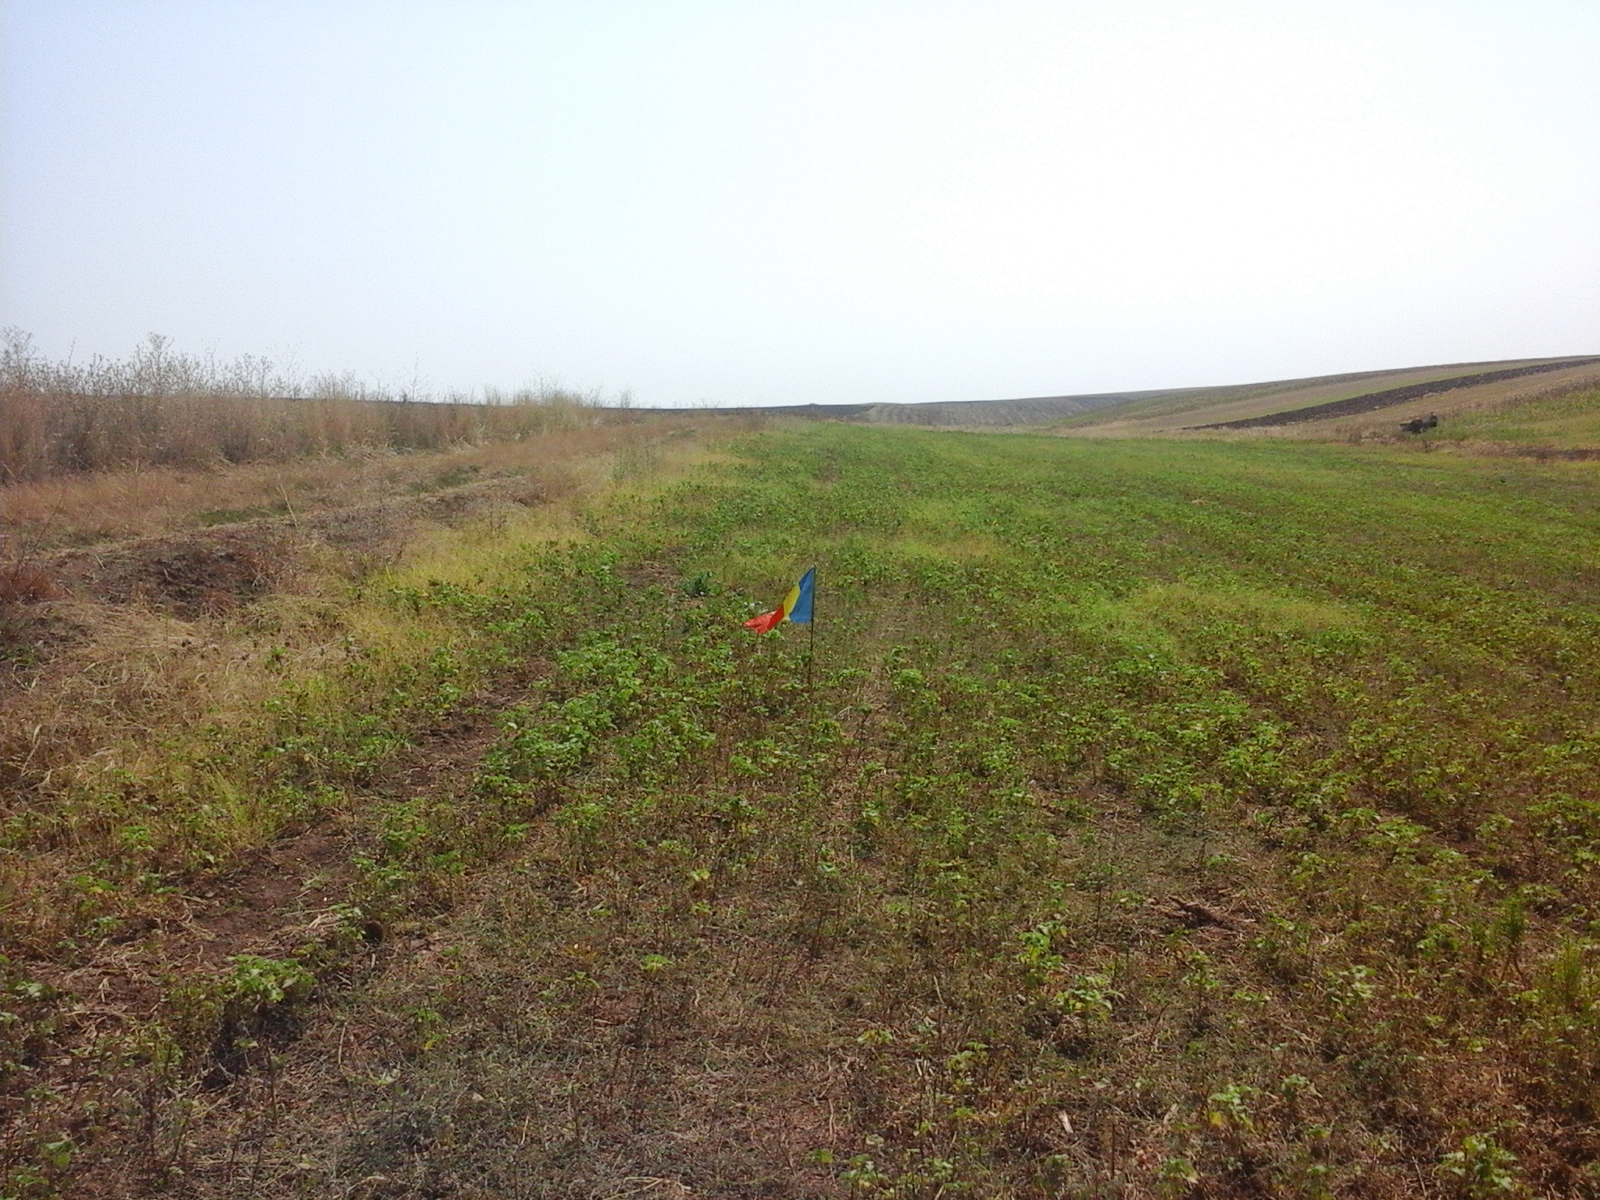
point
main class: Grassland
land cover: Spontaneously vegetated surfaces
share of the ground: > 75 %
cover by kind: herbaceous plants 100 %
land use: Fallow land
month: August
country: RO
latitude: 44.2023
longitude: 23.2994
